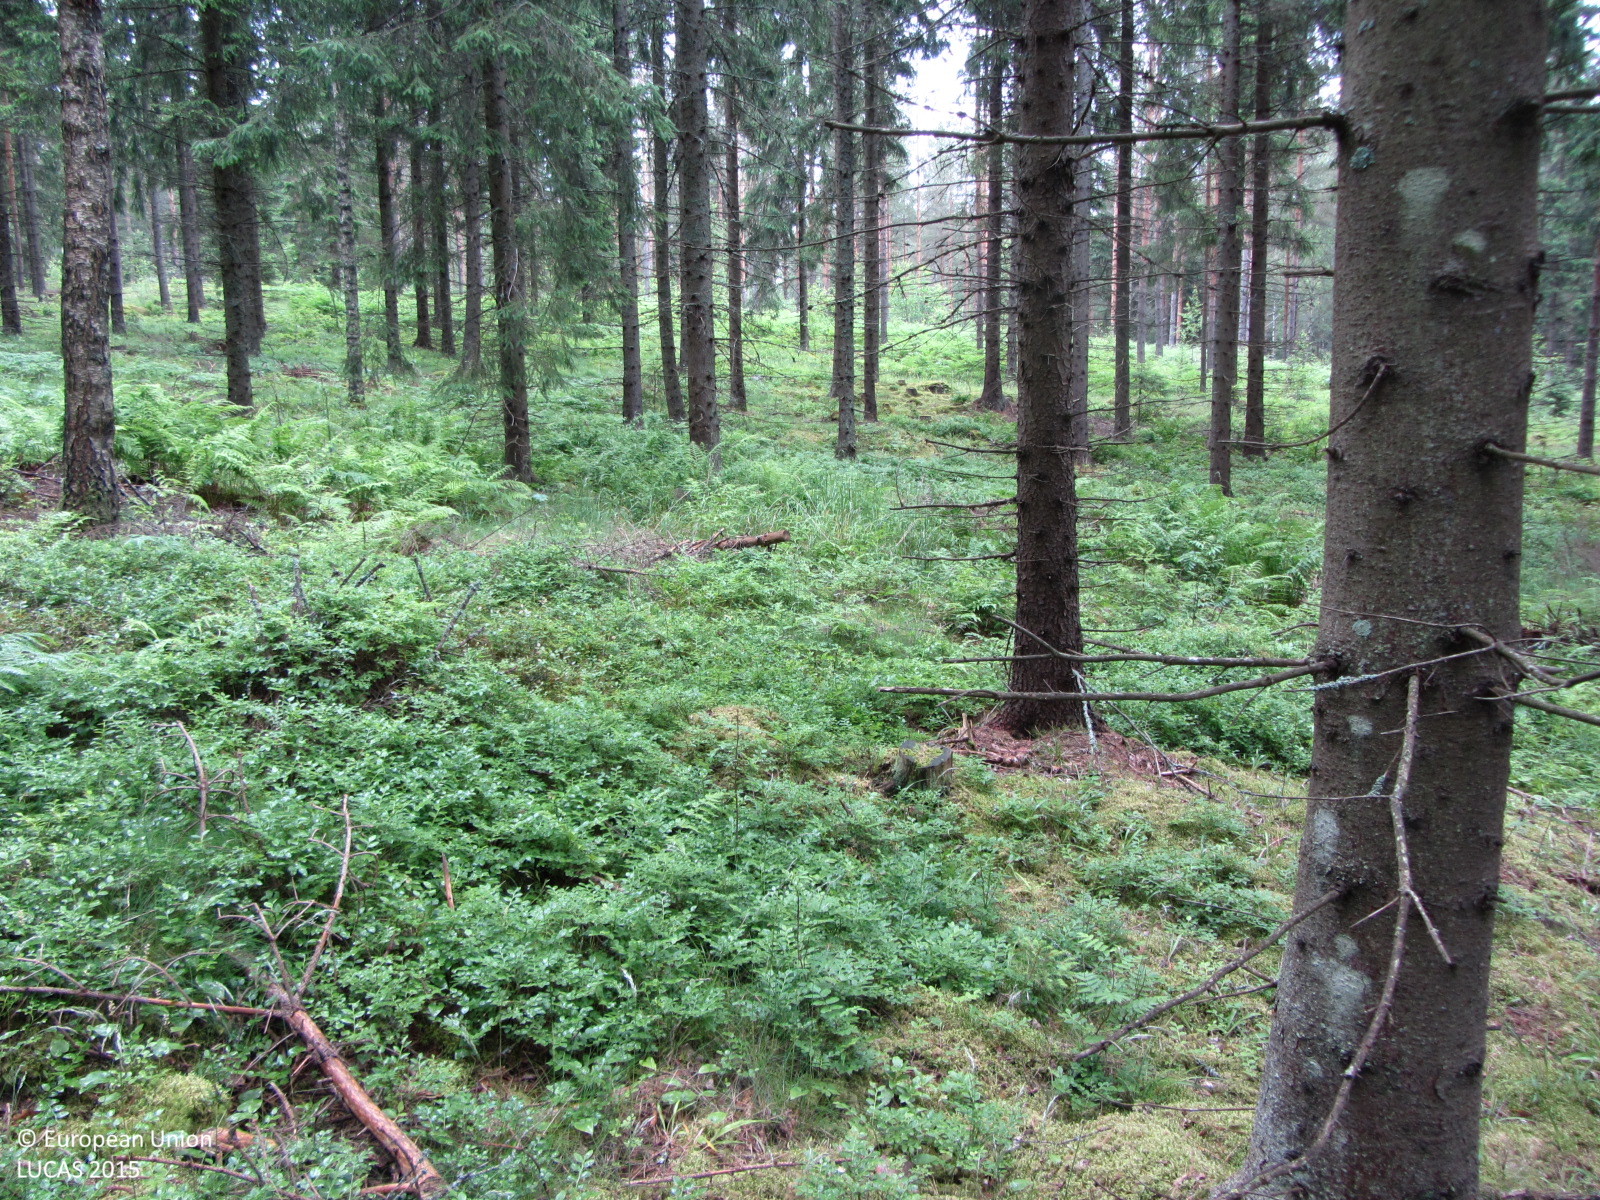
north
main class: Woodland
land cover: Spruce dominated coniferous woodland
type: boreal forest
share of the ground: > 75 %
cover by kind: coniferous forest trees 70 %, herbaceous plants 15 %, broadleaved forest trees 5 %, shrubs 5 %, lichens and mosses 5 %
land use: Forestry
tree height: > 5 m
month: June
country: FI
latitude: 60.1972
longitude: 23.1967
